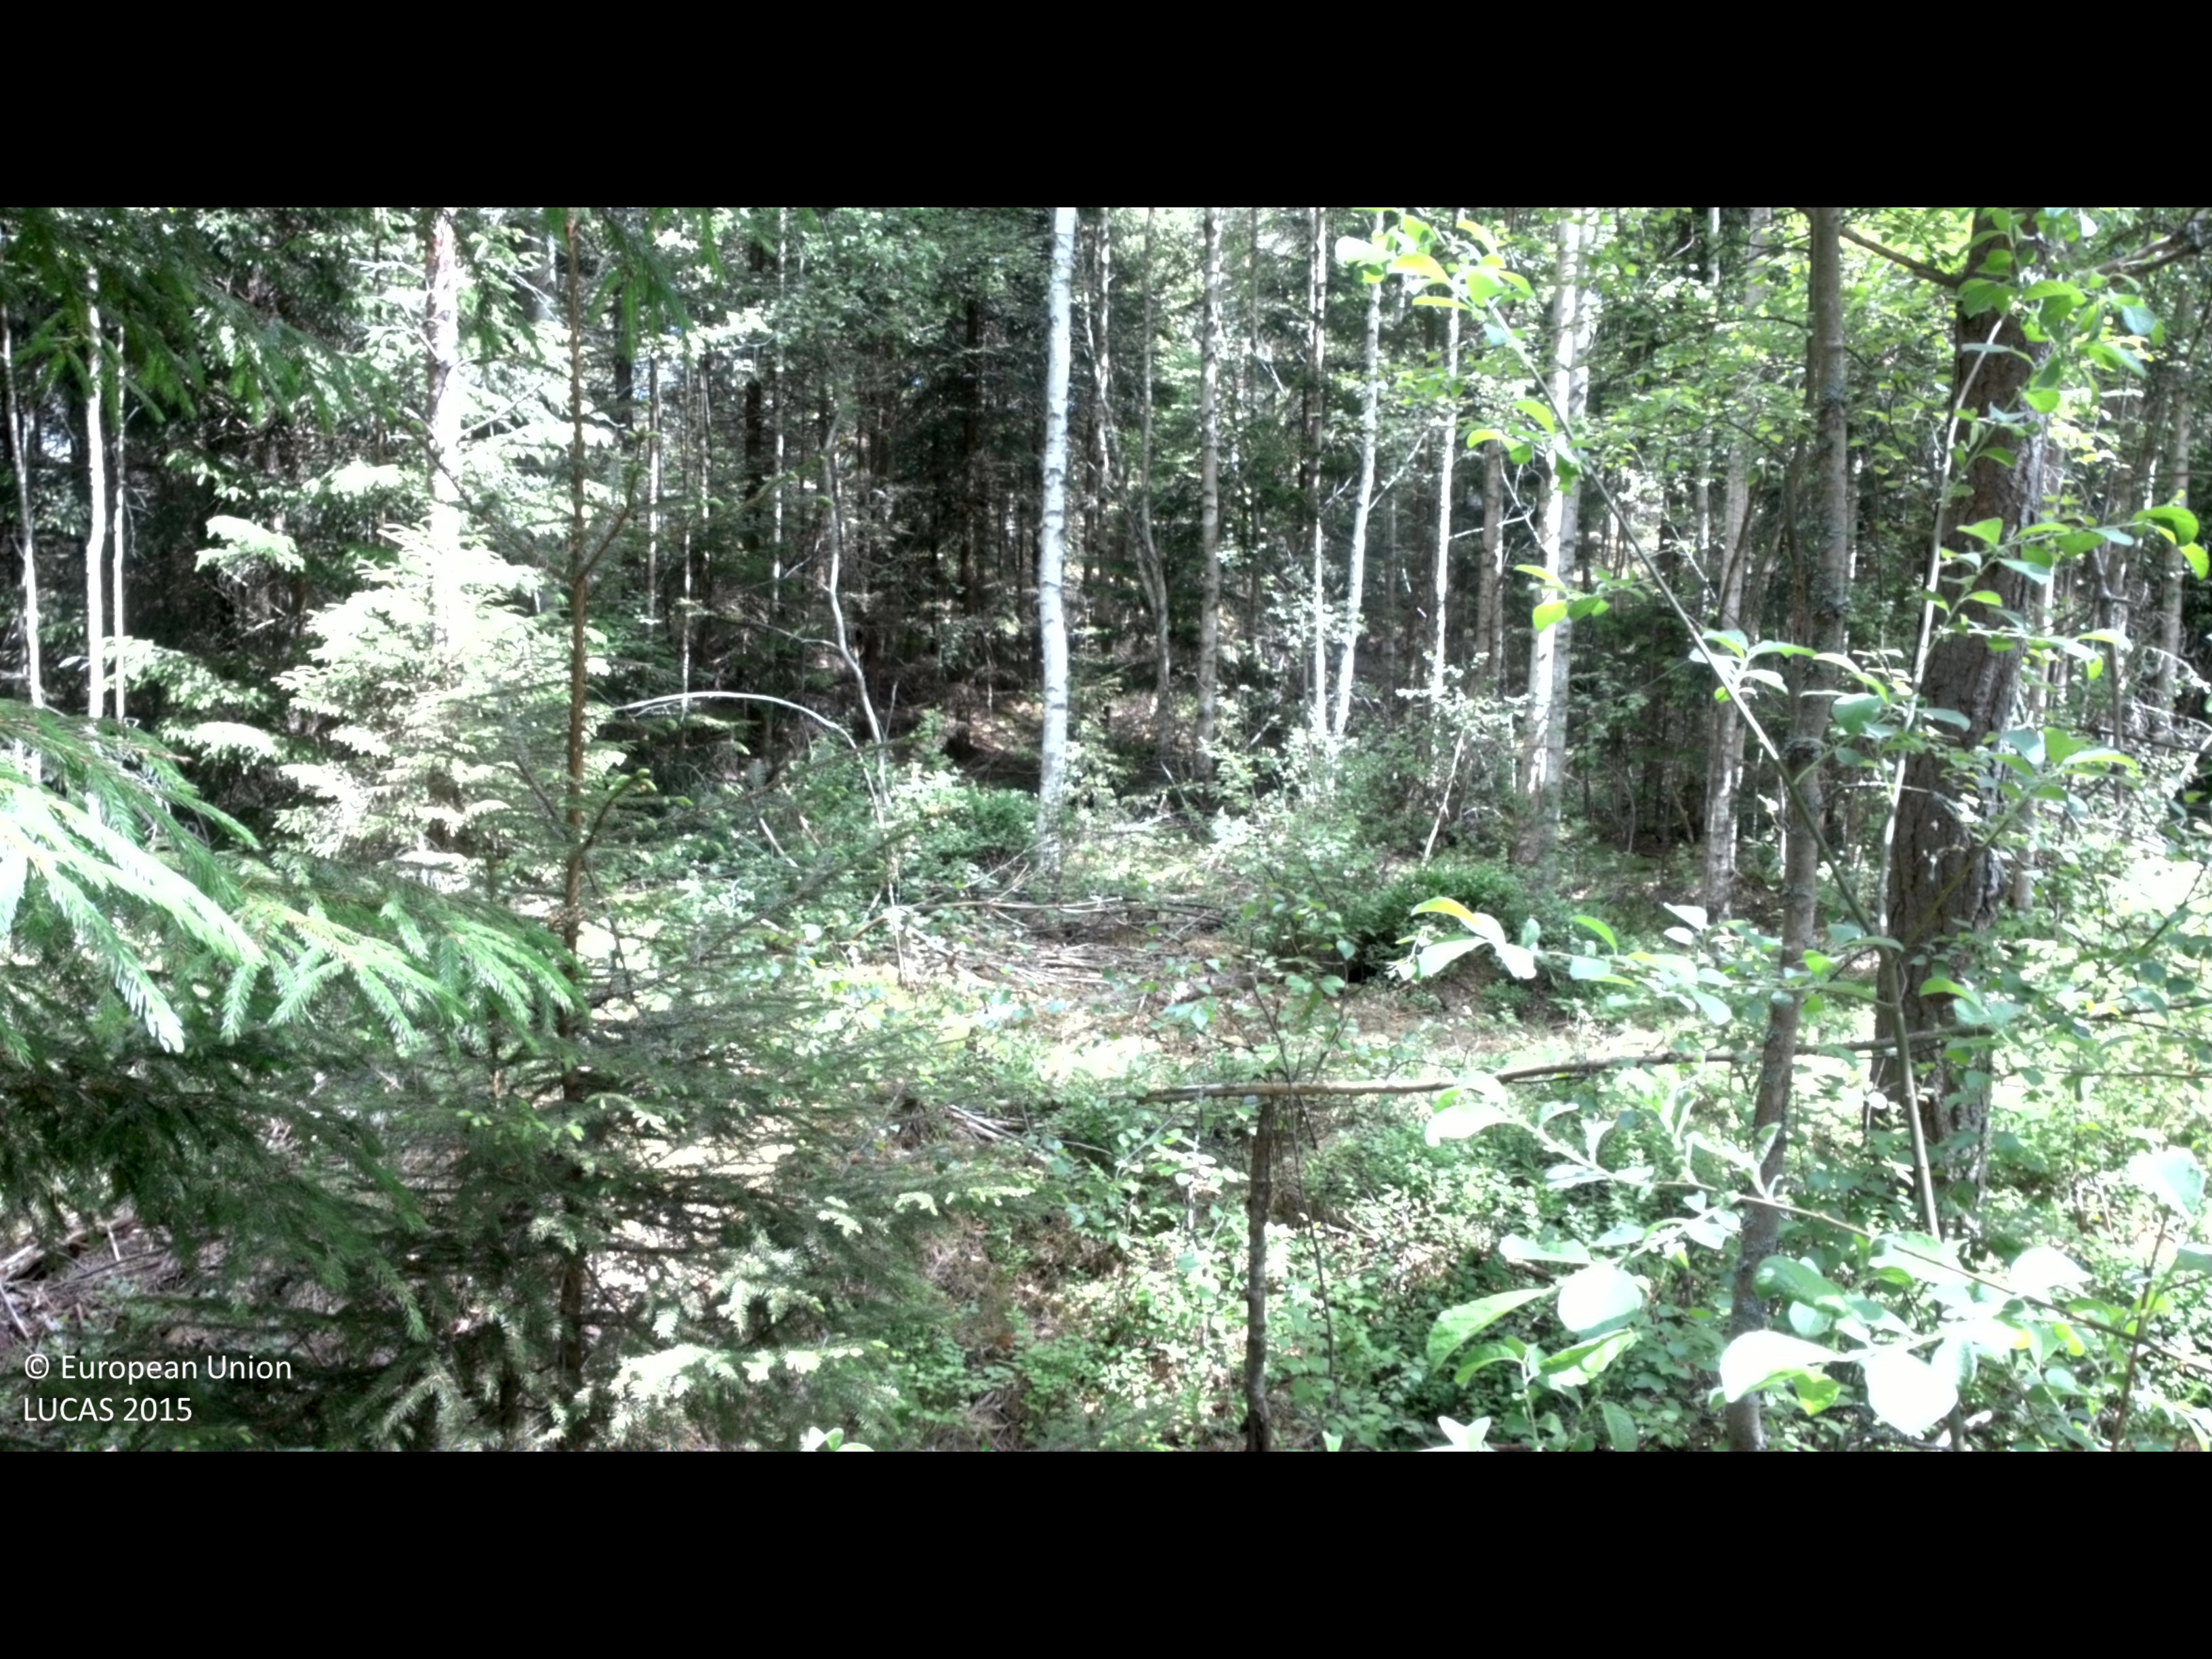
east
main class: Woodland
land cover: Pine dominated mixed woodland
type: boreal forest
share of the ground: > 75 %
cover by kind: coniferous forest trees 45 %, broadleaved forest trees 35 %, shrubs 10 %, lichens and mosses 10 %
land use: Forestry
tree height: > 5 m
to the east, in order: Pine dominated mixed woodland; Spruce dominated mixed woodland; Pine dominated mixed woodland; Pine dominated coniferous woodland; Spruce dominated coniferous woodland; Broadleaved woodland; Ditches and canals; Grassland without tree/shrub cover
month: June
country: SE
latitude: 57.6917
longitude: 16.6926
